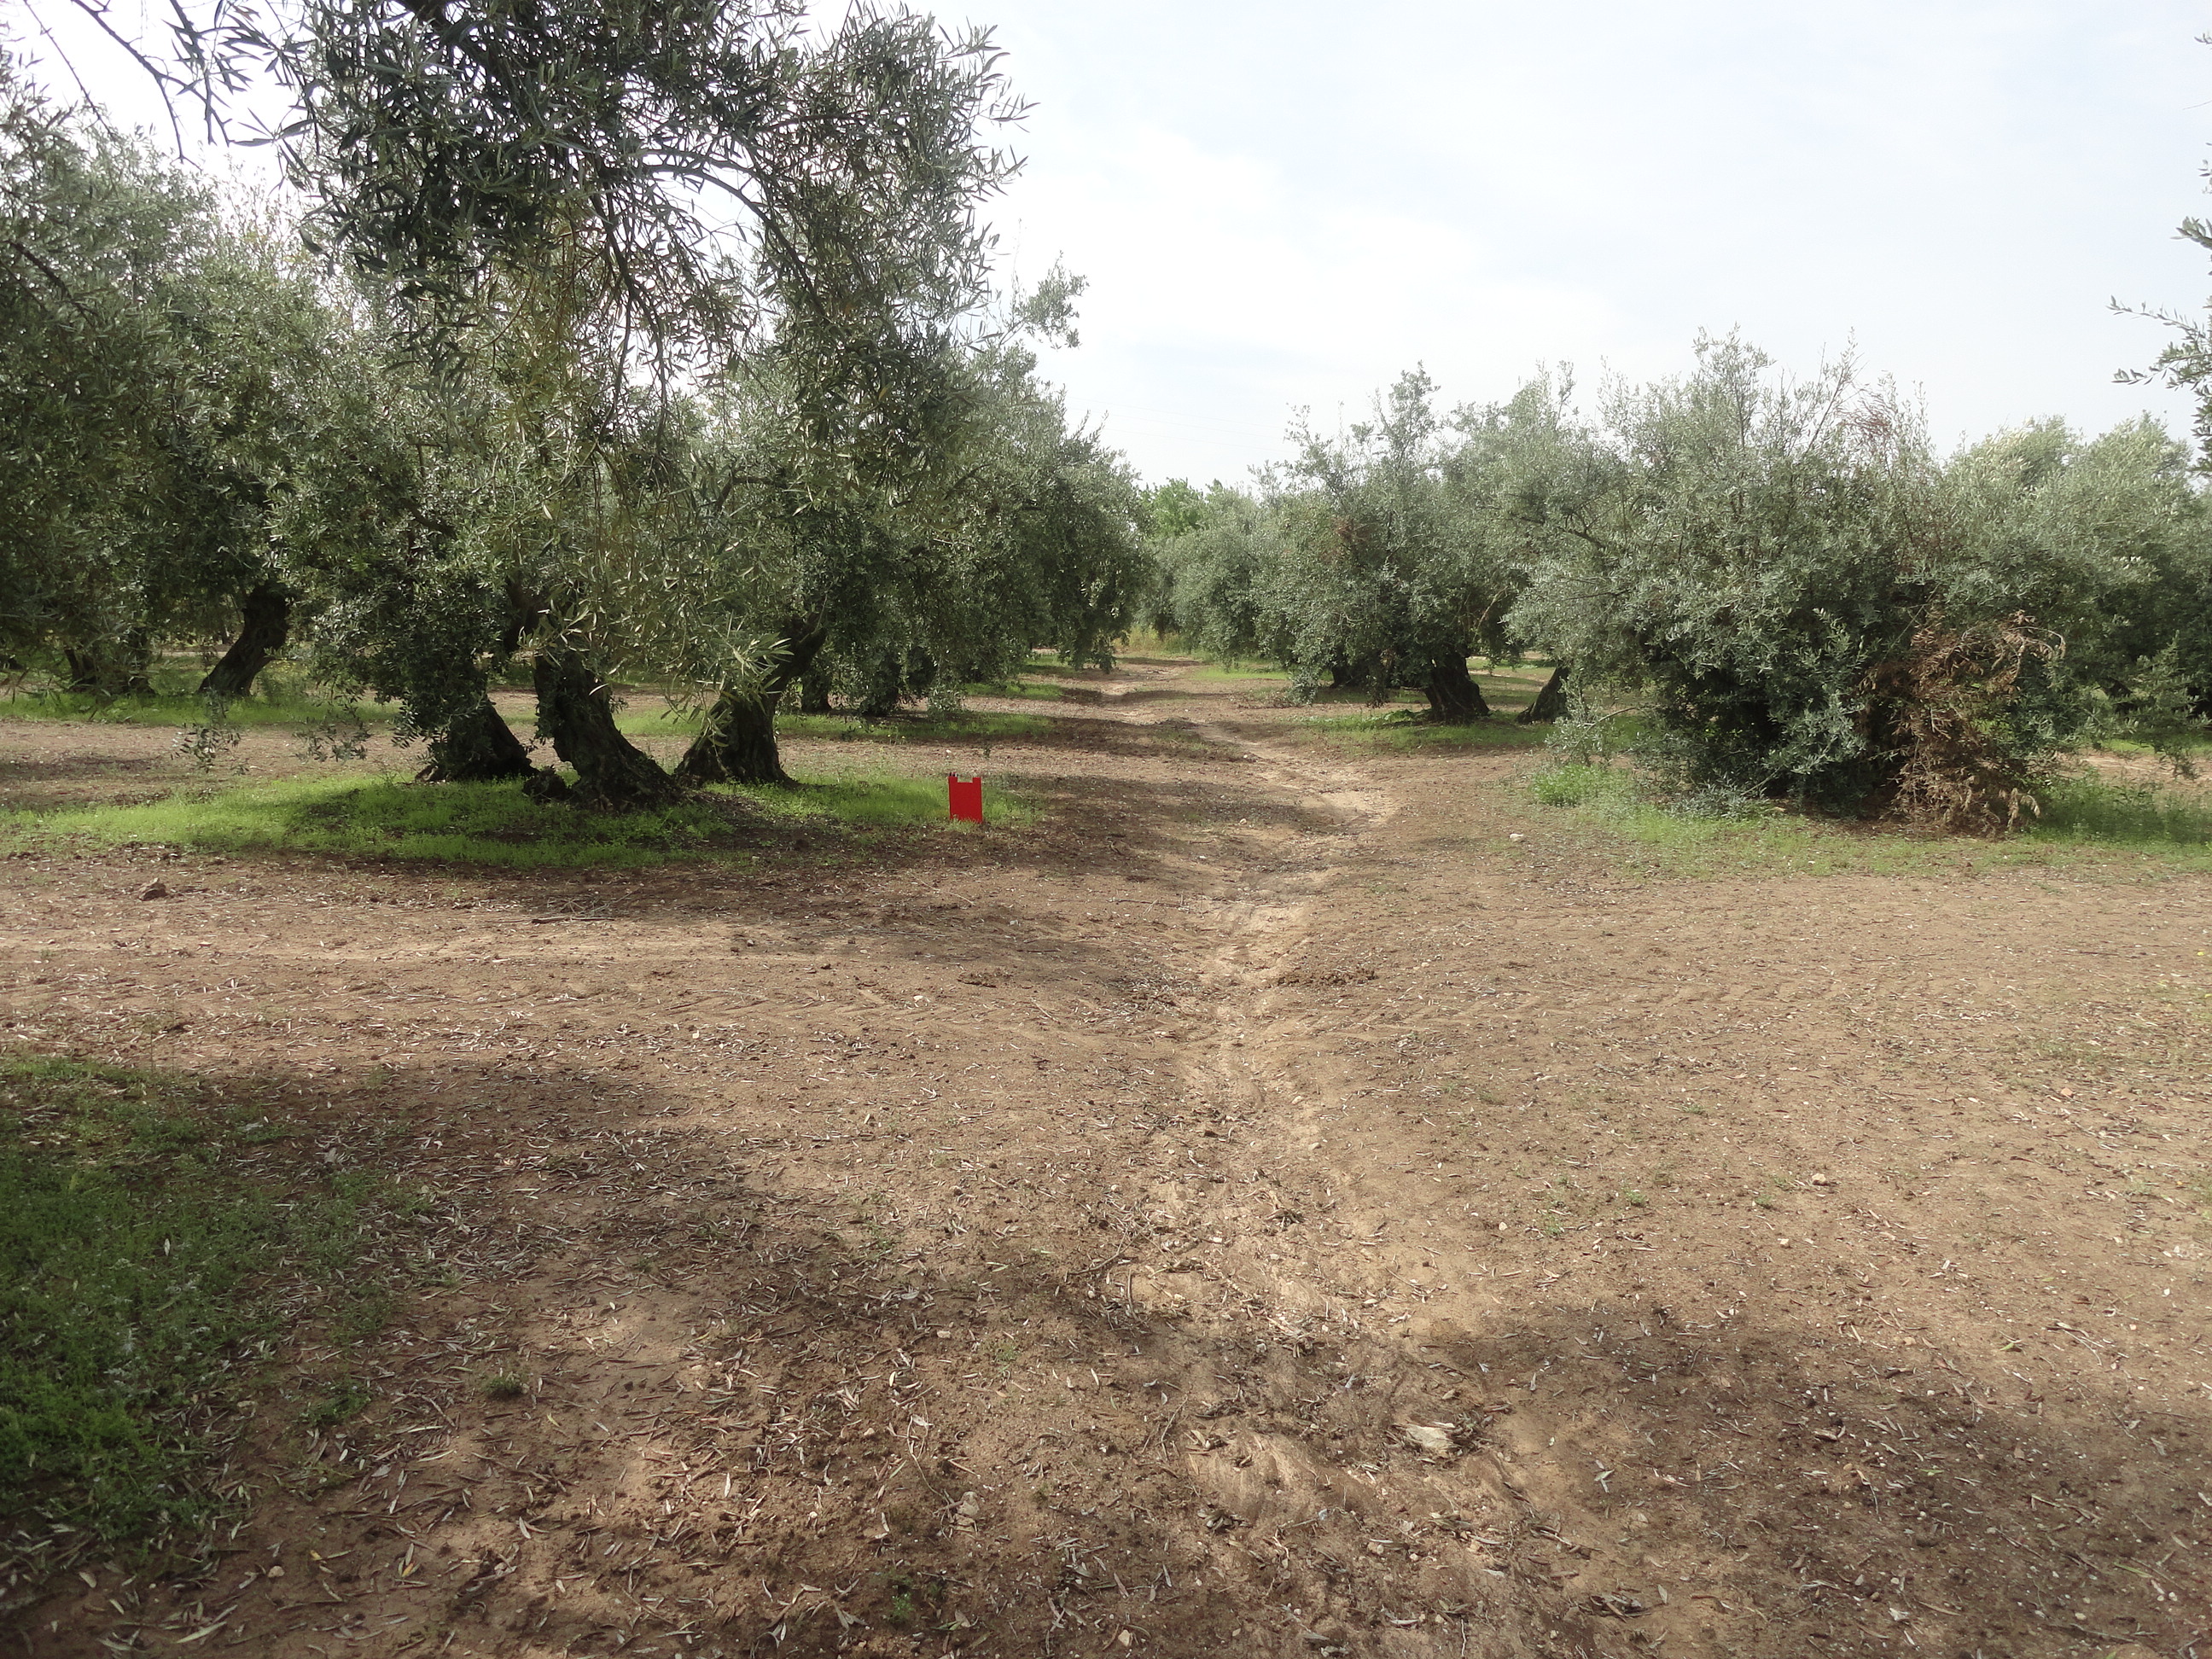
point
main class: Cropland
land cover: Olive groves
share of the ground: 50 - 75 %
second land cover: Spontaneously vegetated surfaces
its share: 10 - 25 %
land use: Agriculture (excluding fallow land and kitchen gardens)
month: April
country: ES
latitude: 37.5347
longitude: -4.5934
